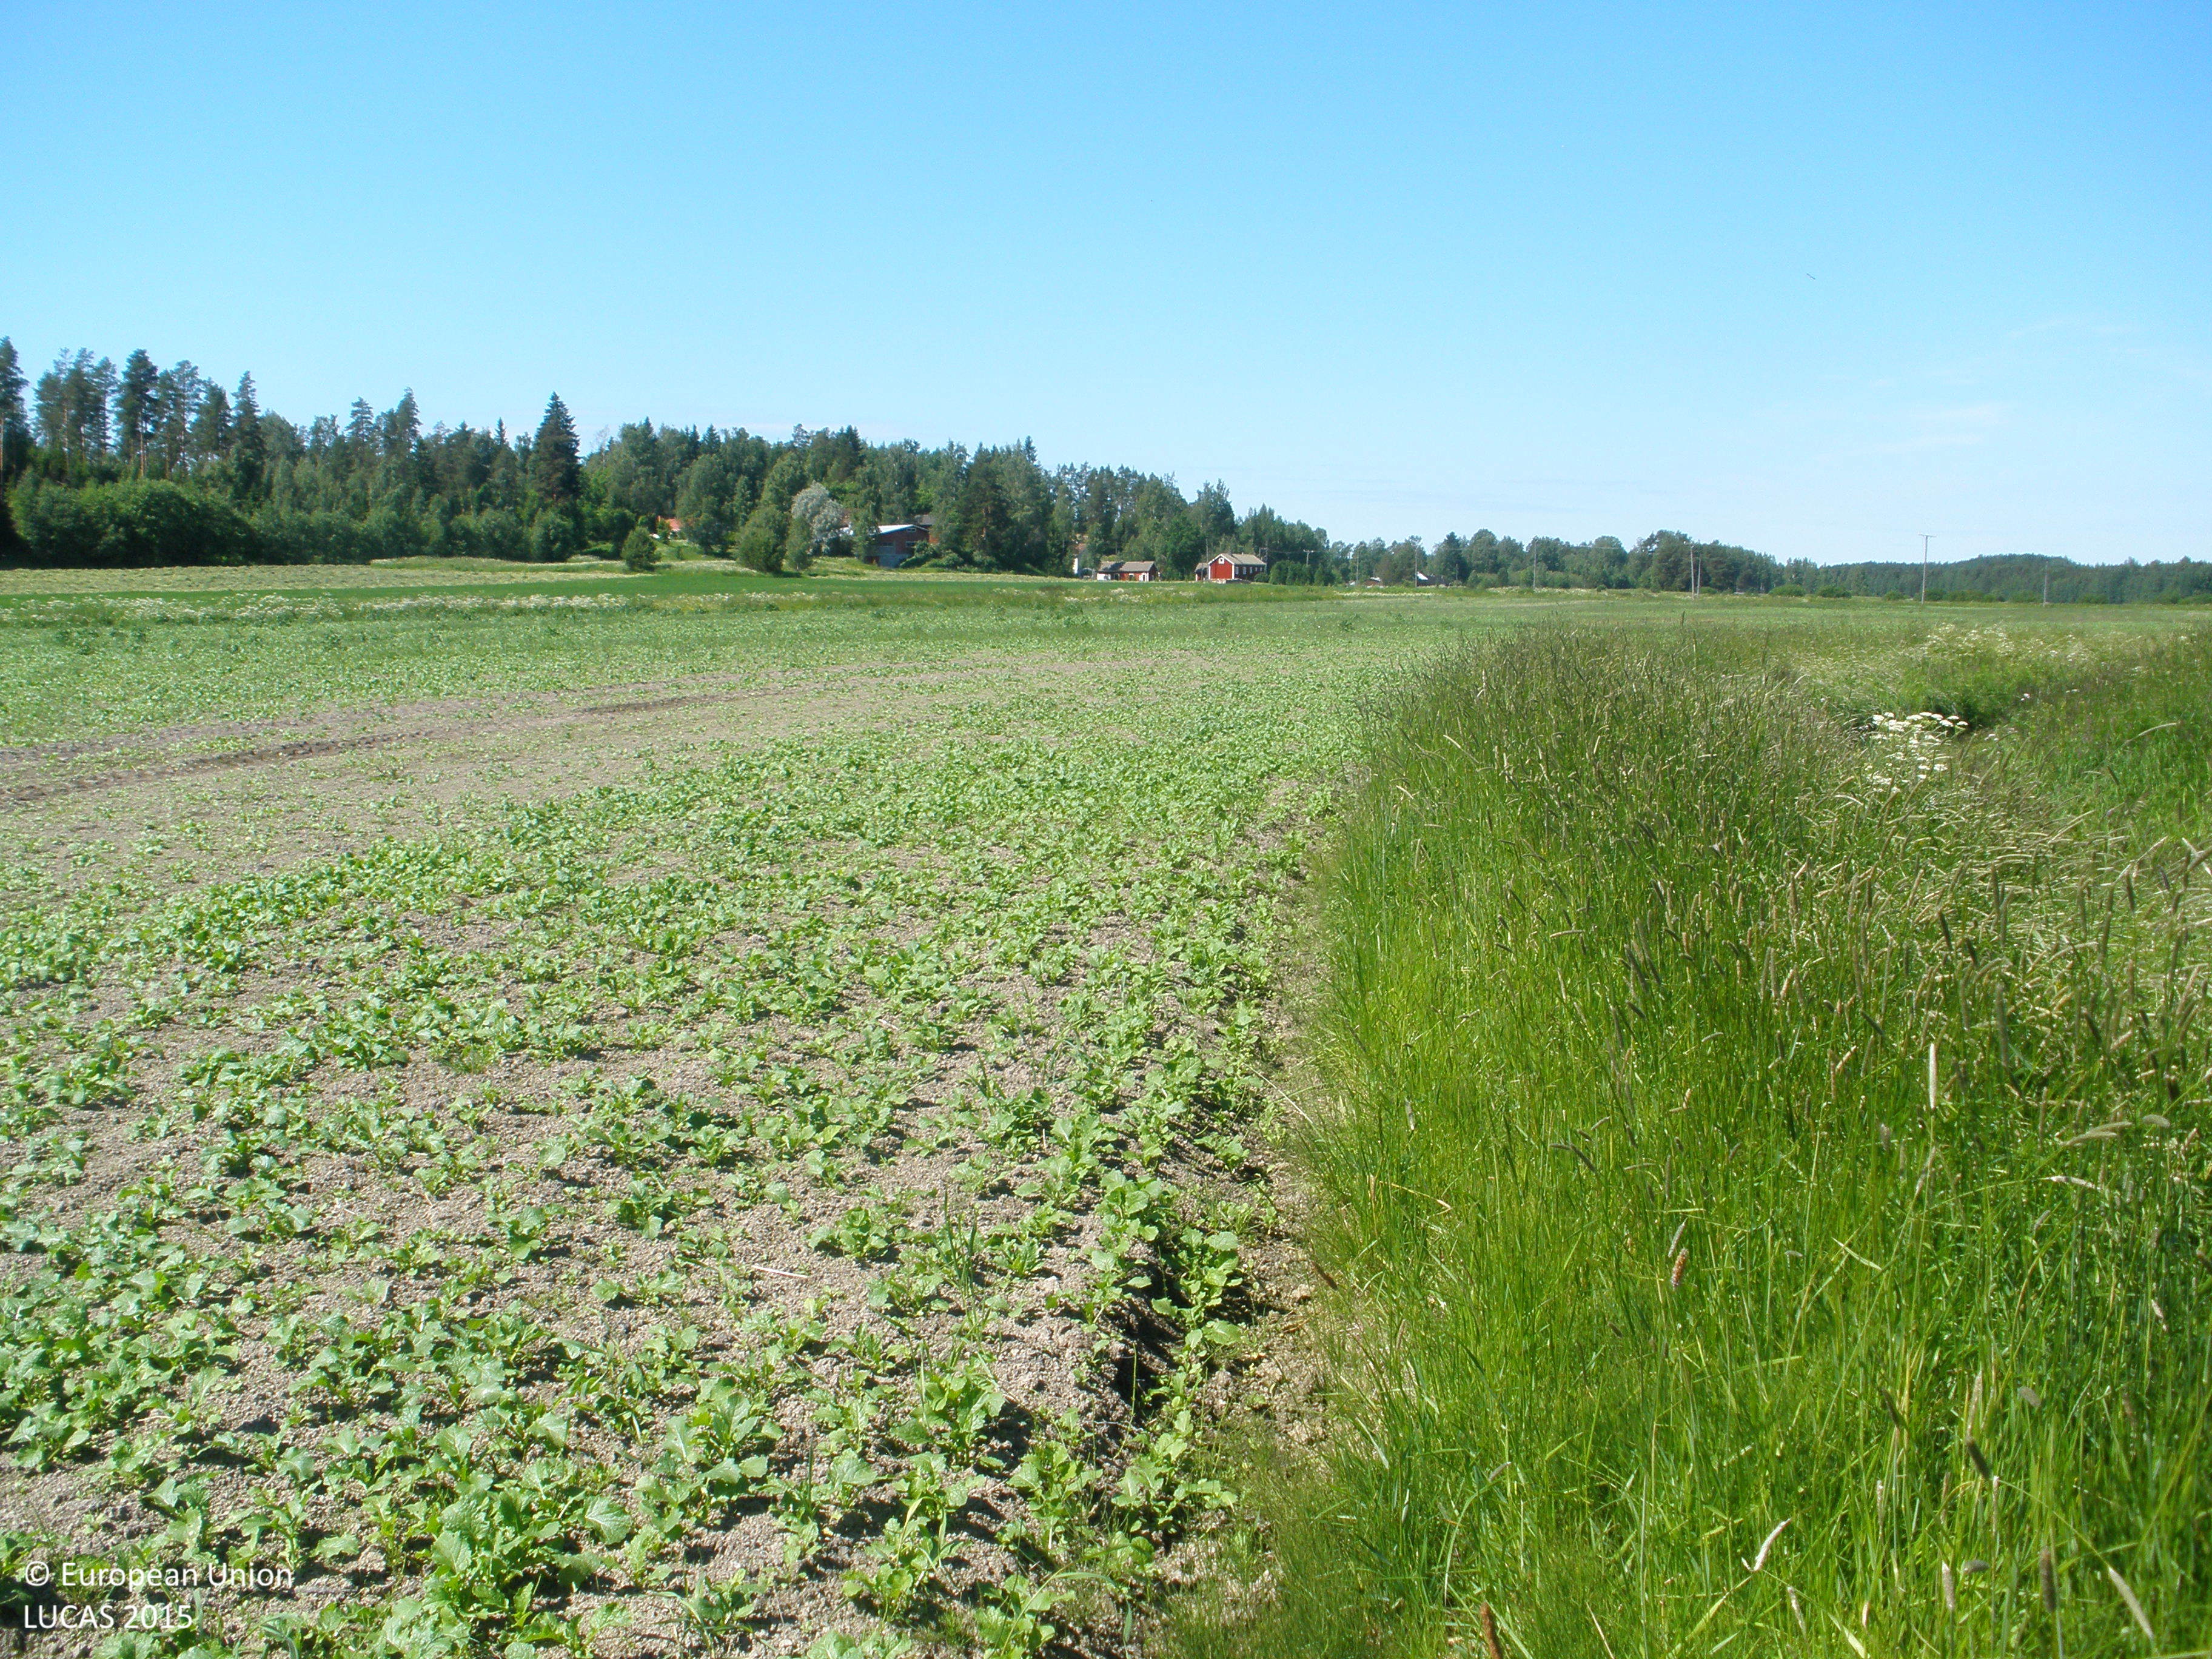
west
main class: Cropland
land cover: Other root crops
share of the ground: 10 - 25 %
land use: Agriculture (excluding fallow land and kitchen gardens)
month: July
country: FI
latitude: 61.0470
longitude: 23.6973
